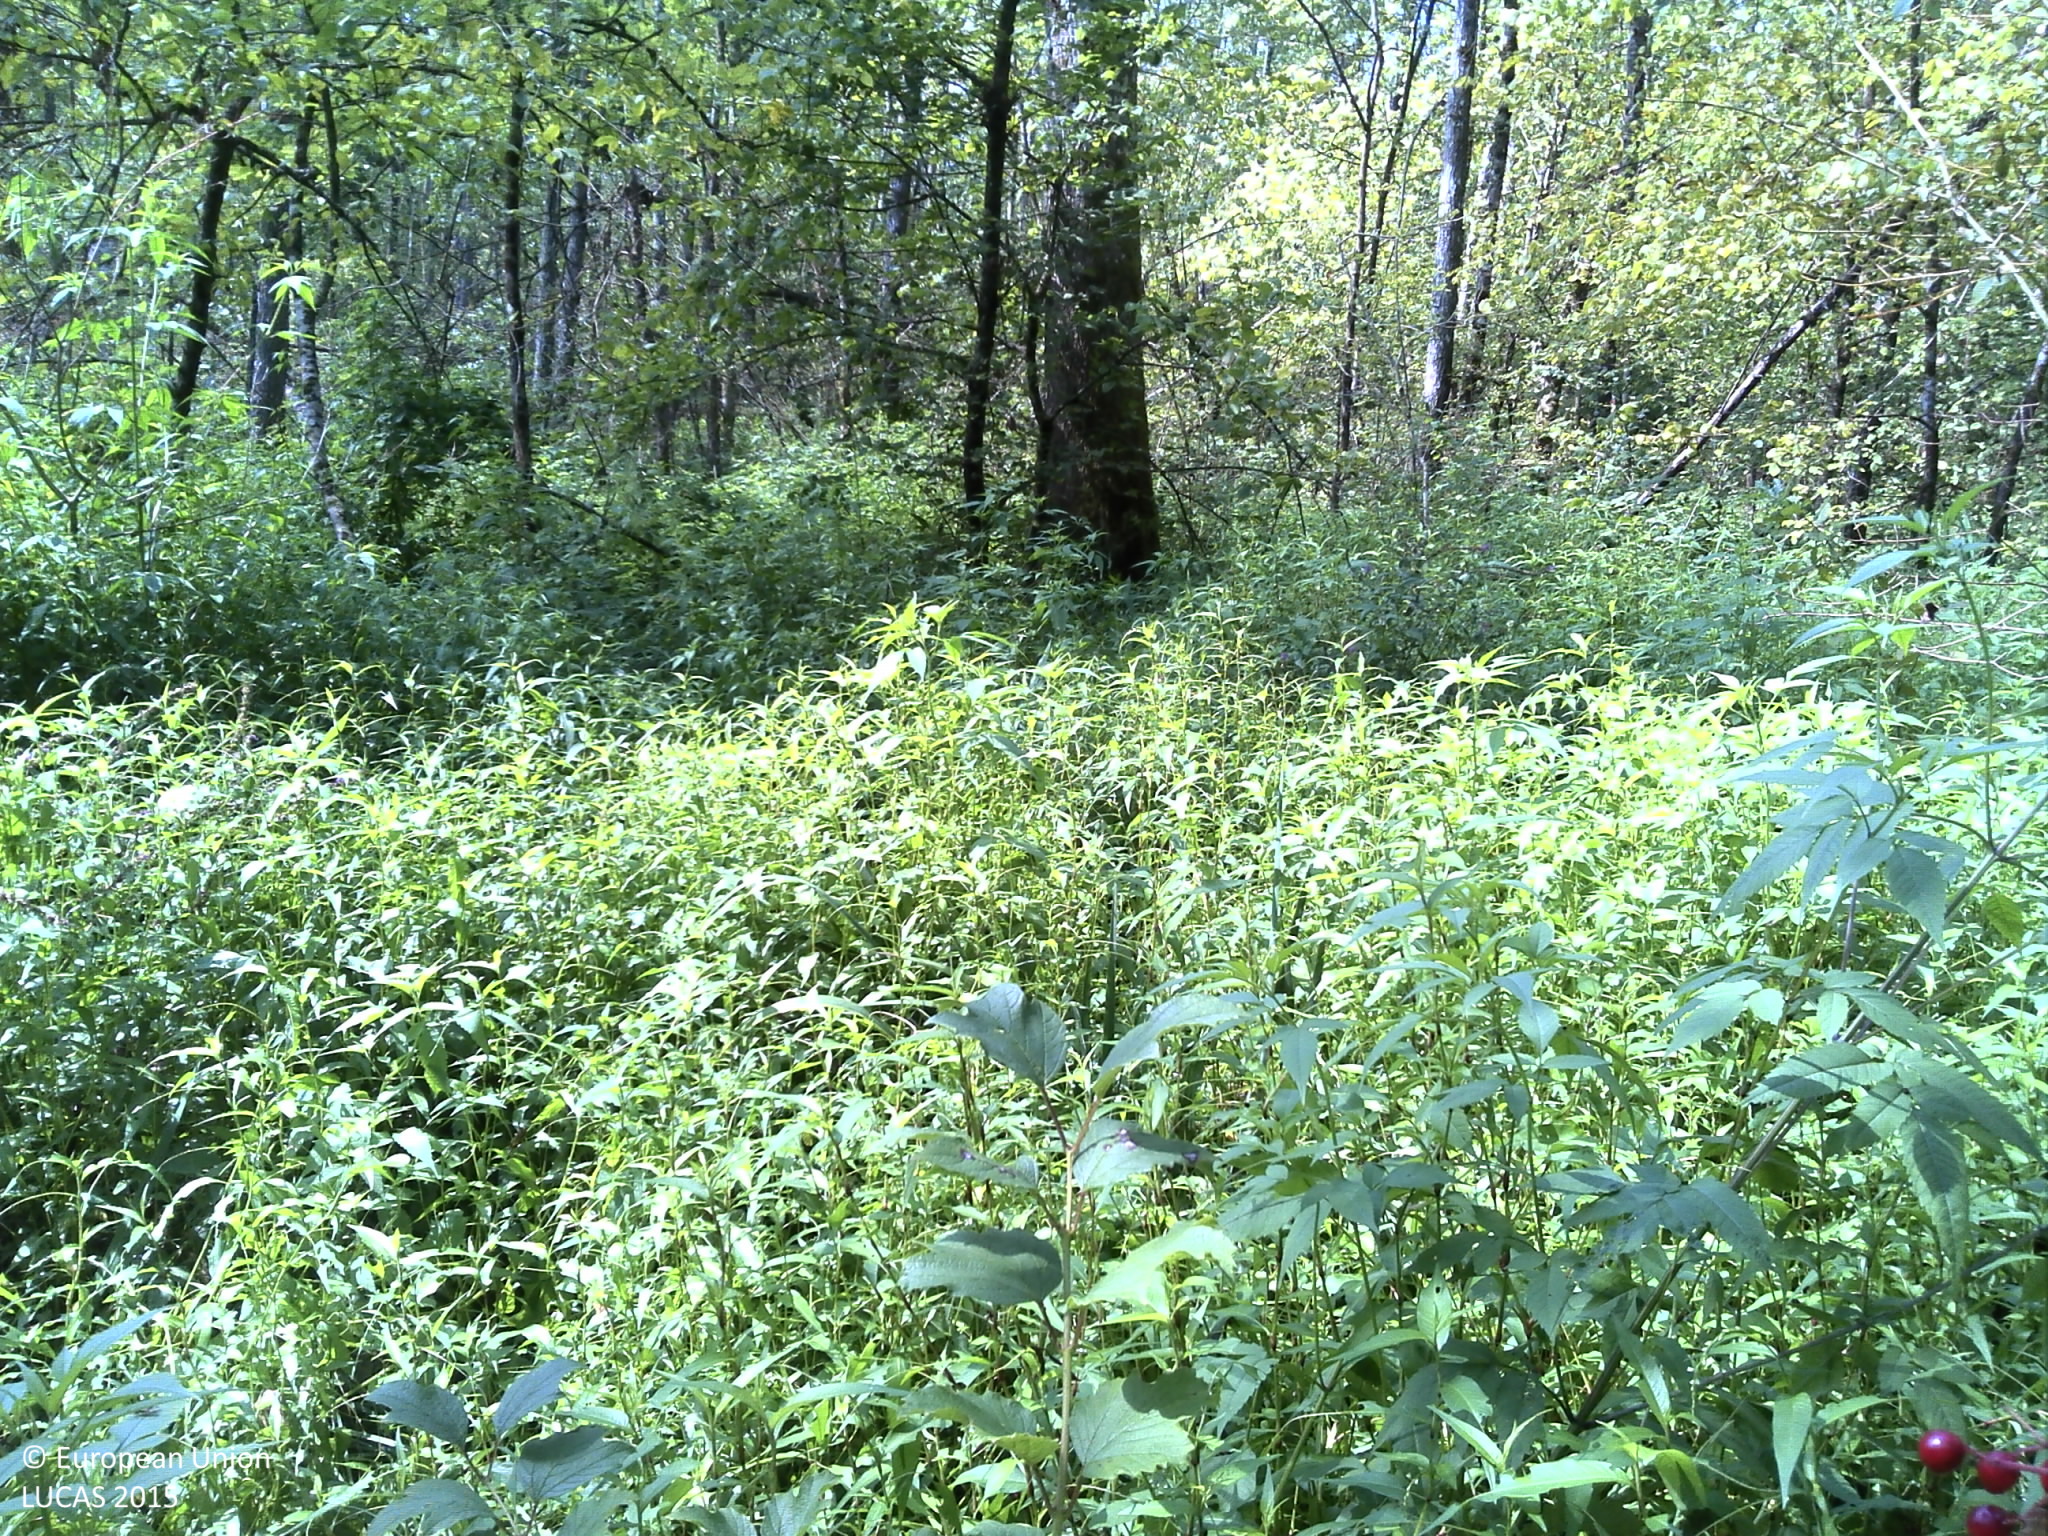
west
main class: Woodland
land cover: Broadleaved woodland
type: mesophytic deciduous forest
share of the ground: > 75 %
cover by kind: broadleaved forest trees 100 %
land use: Forestry
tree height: > 5 m
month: August
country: HR
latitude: 45.5838
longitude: 15.7258
